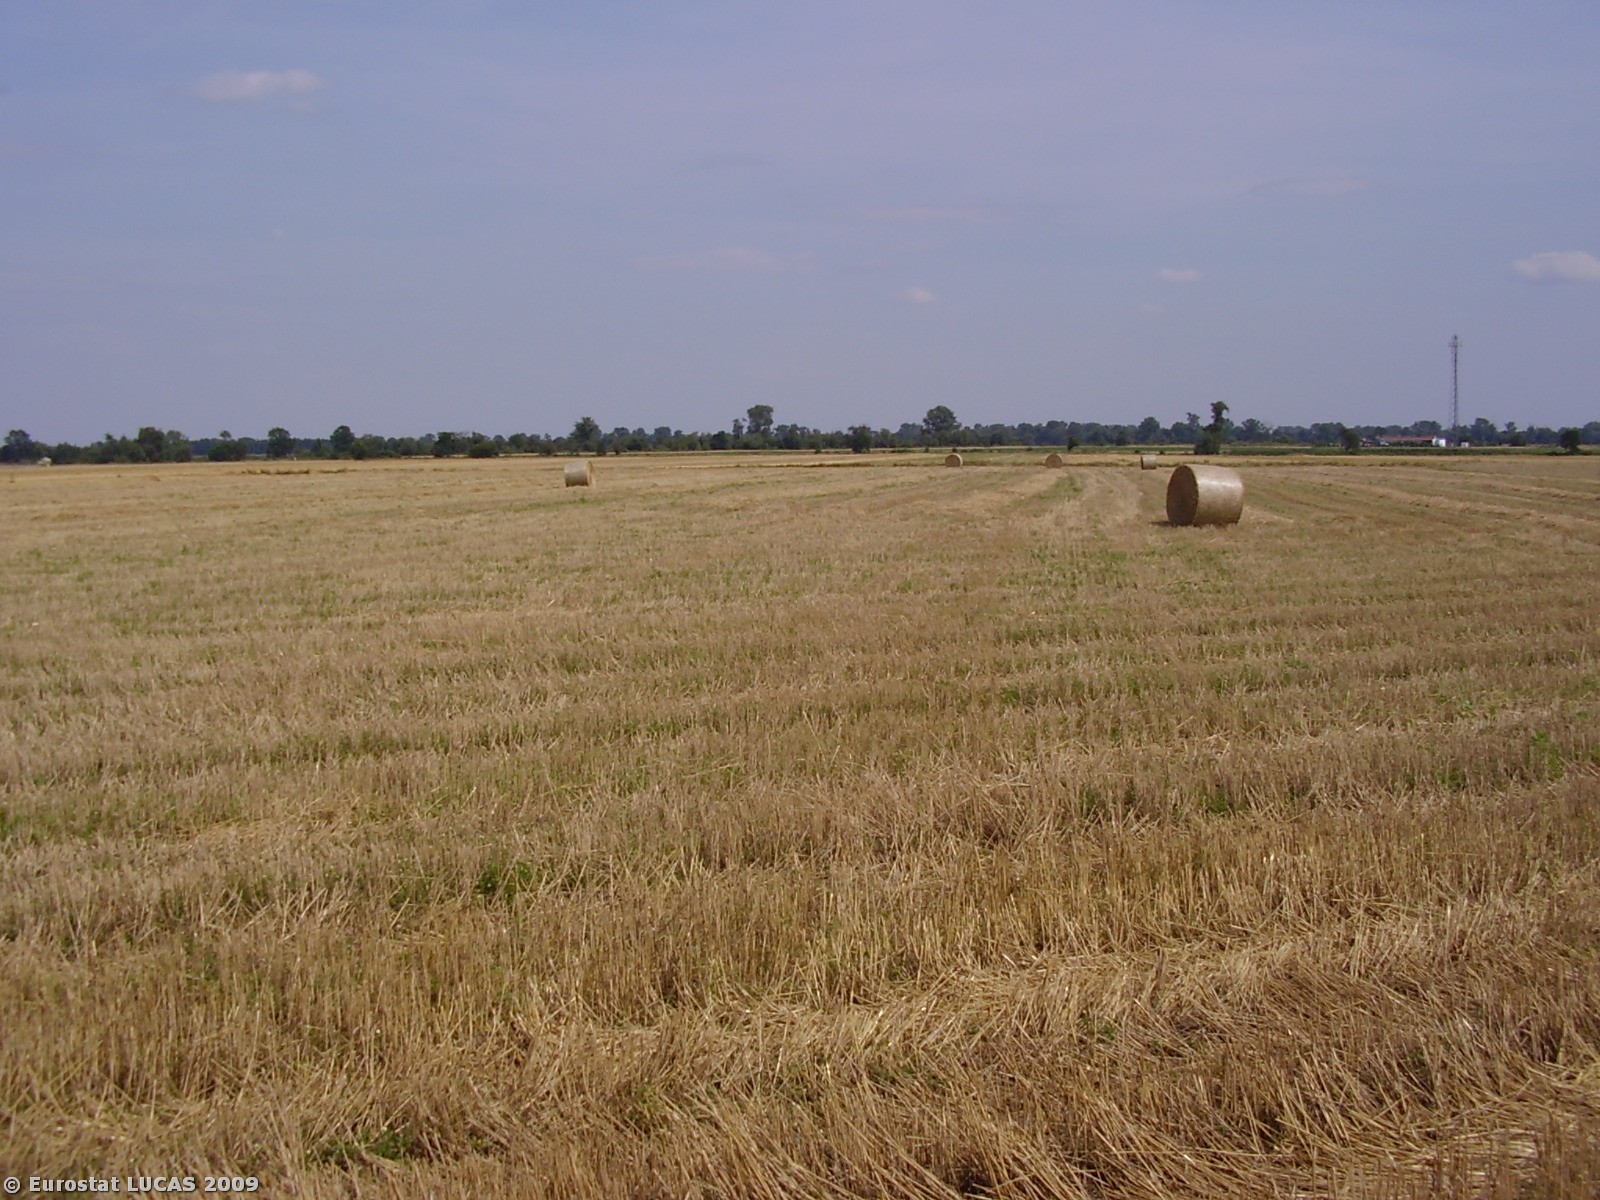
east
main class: Cropland
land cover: Common wheat
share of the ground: < 10 %
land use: Agriculture (excluding fallow land and kitchen gardens)
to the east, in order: Common wheat; Tracks; Common wheat
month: August
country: PL
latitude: 51.6039
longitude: 16.1717
